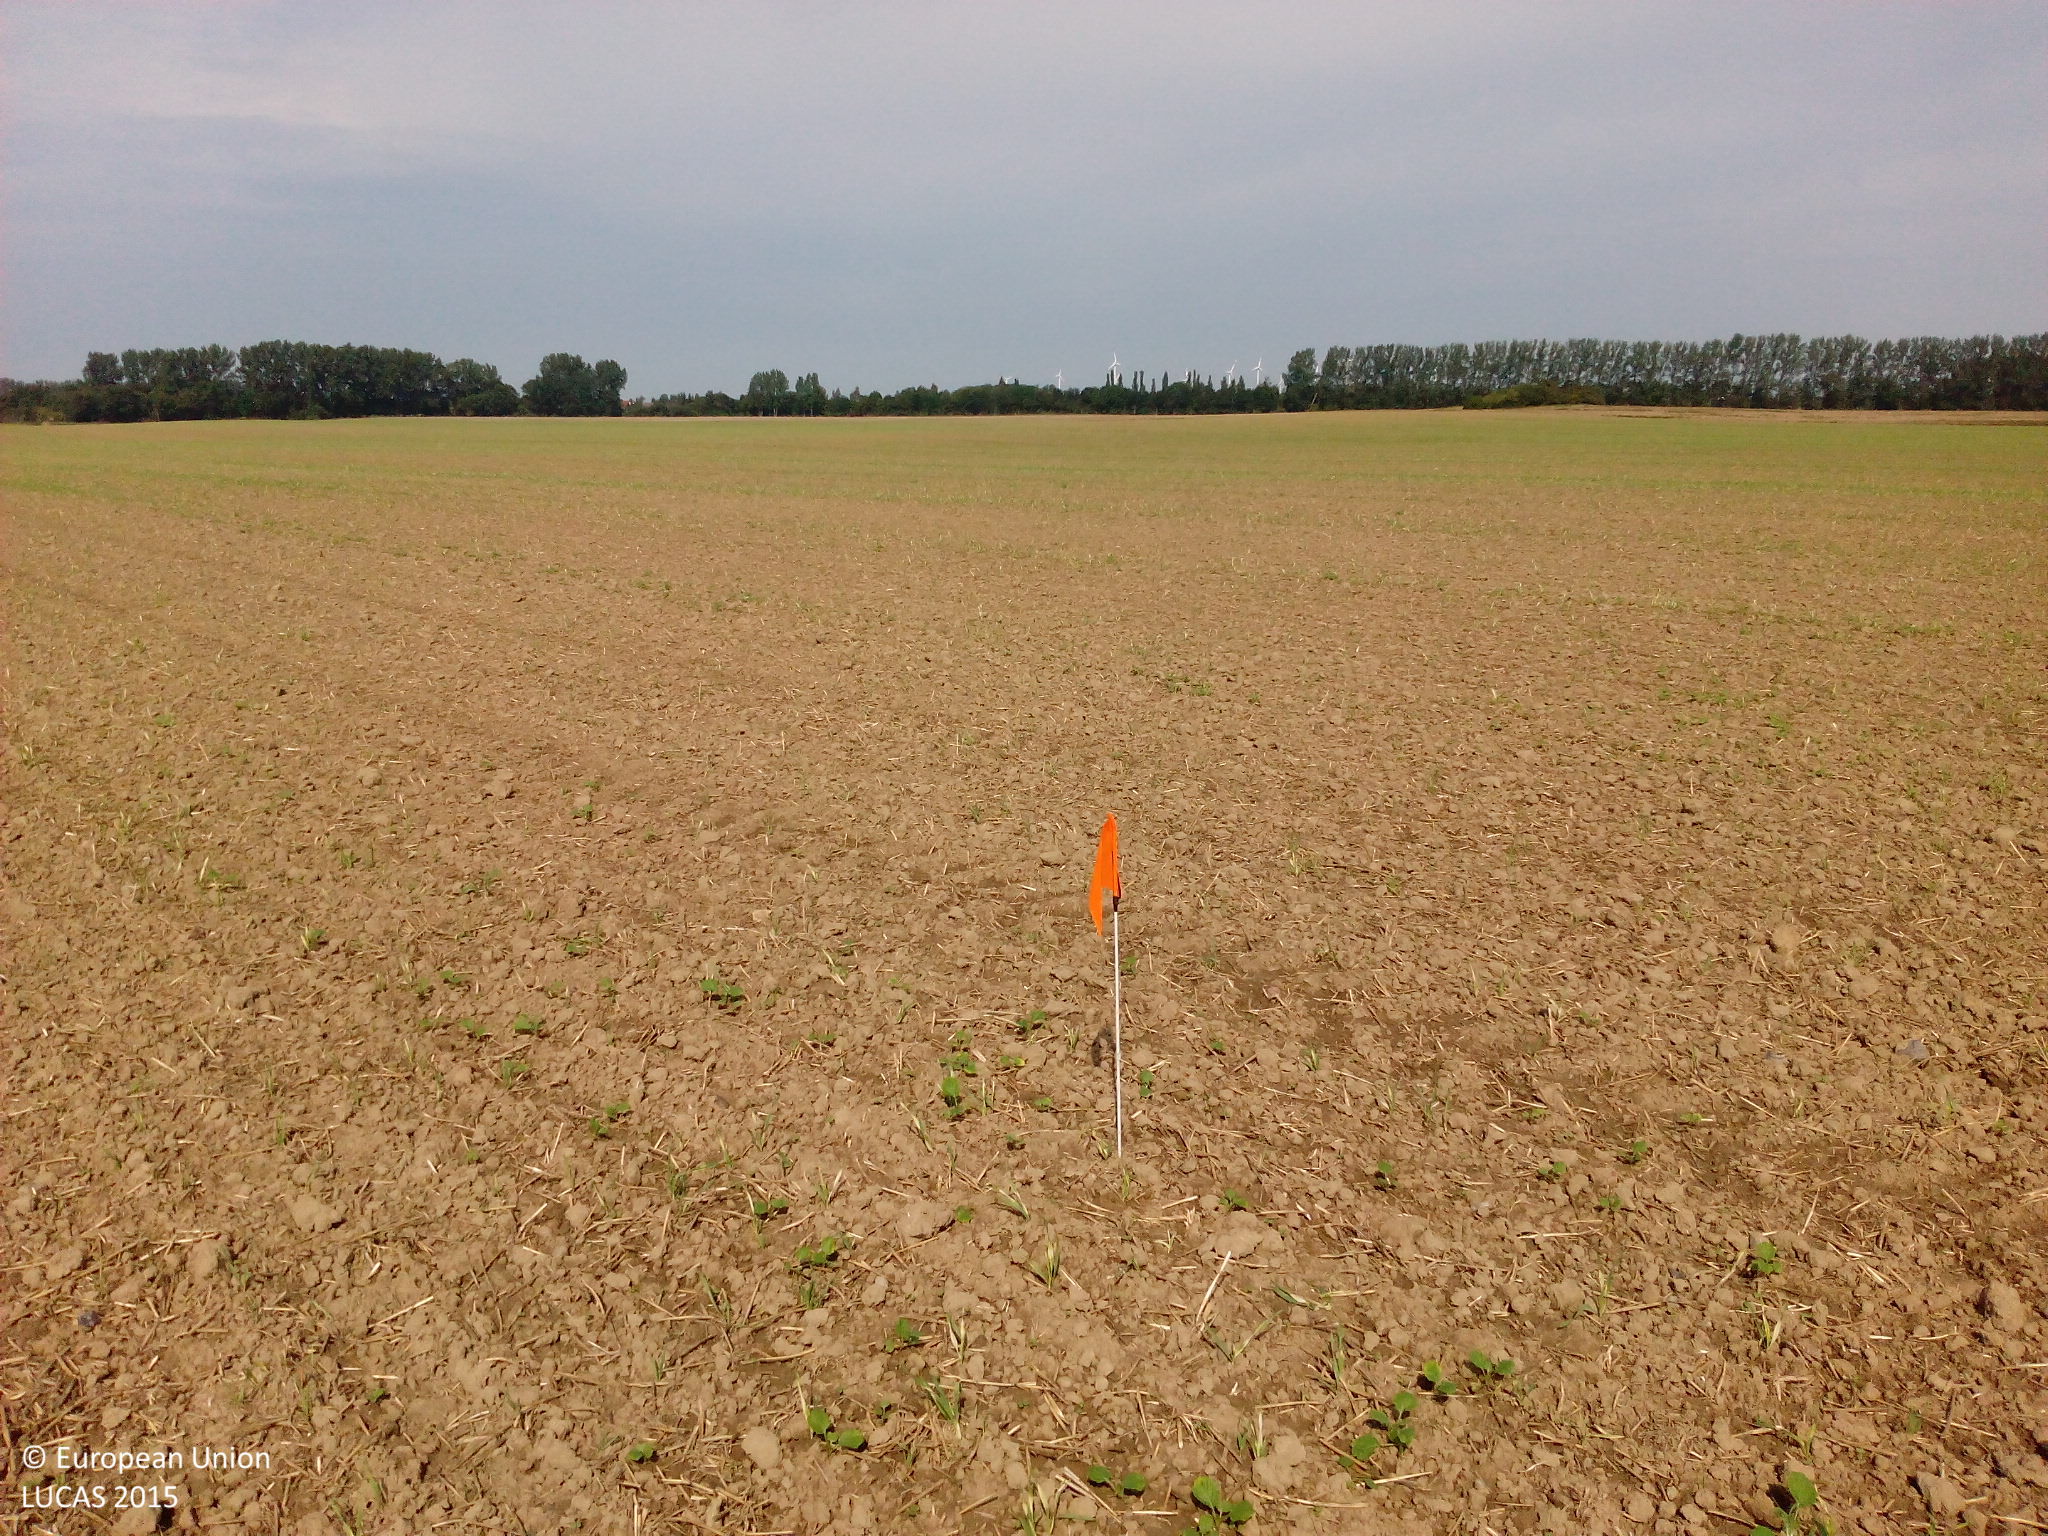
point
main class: Cropland
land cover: Rape and turnip rape
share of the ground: < 10 %
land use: Agriculture (excluding fallow land and kitchen gardens)
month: August
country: DE
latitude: 54.2367
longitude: 12.6226
